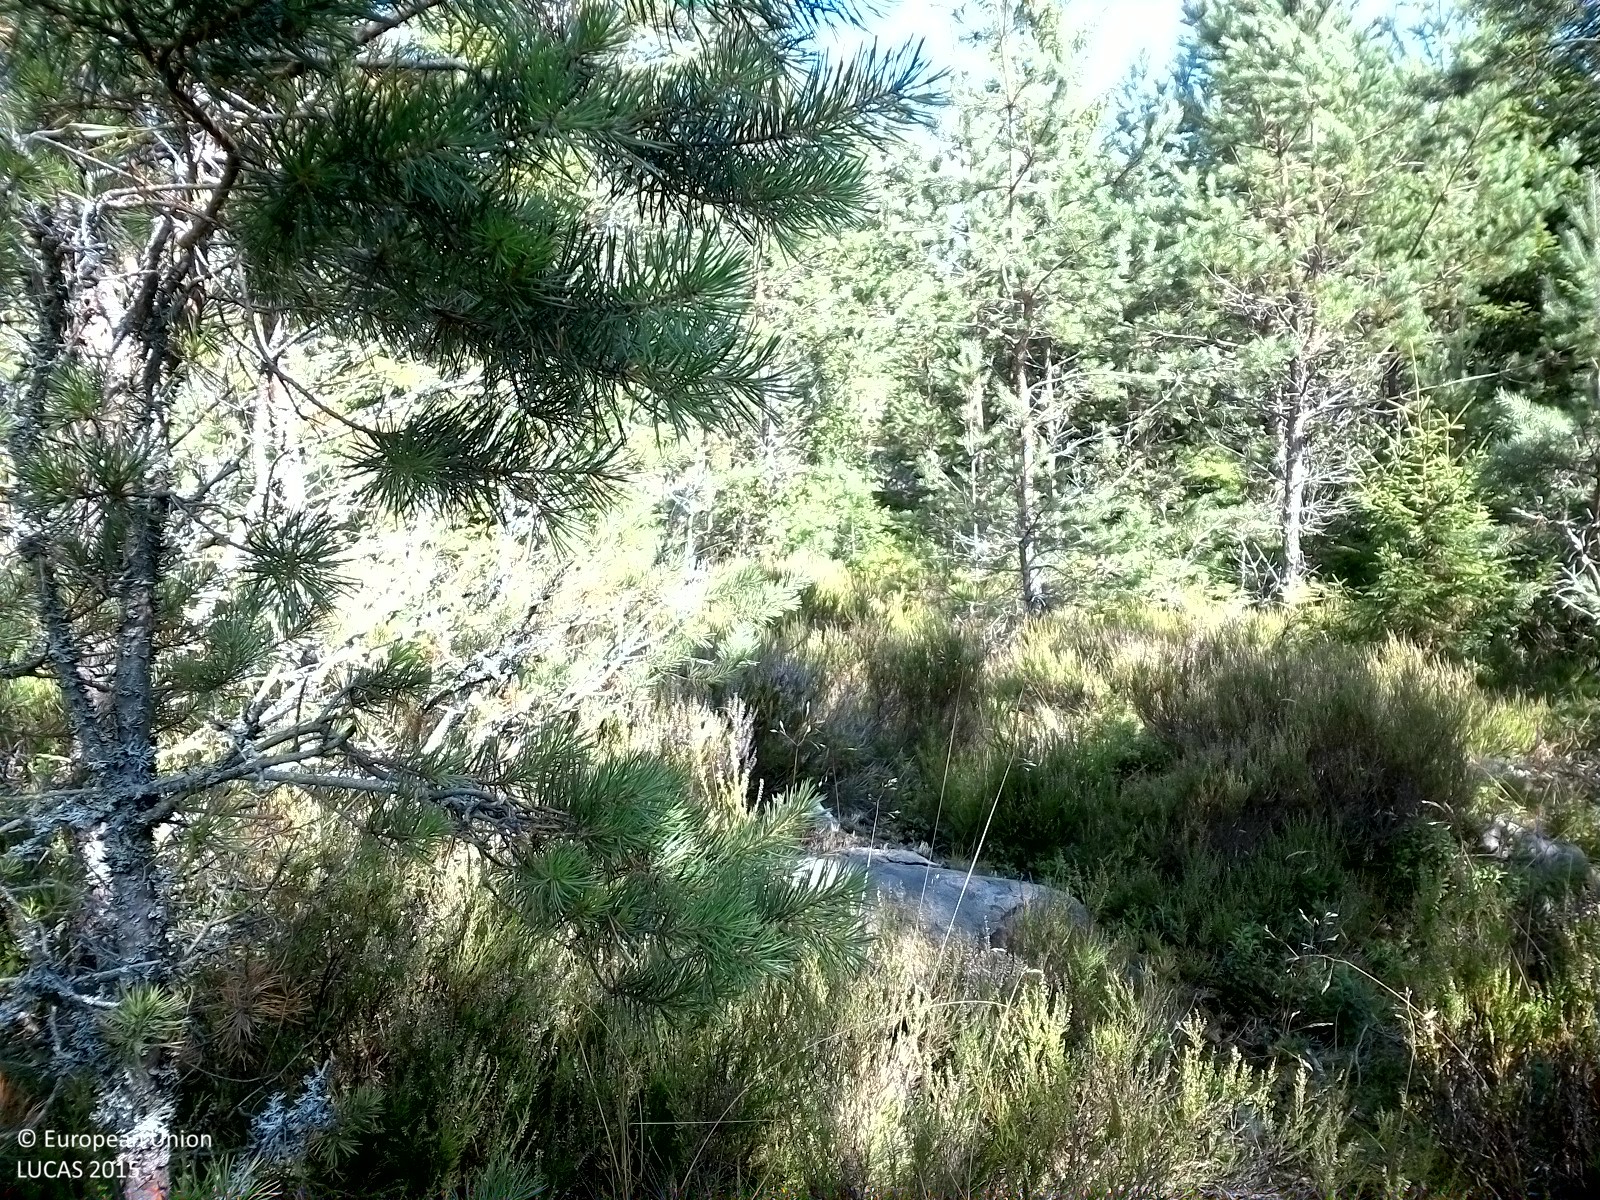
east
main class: Woodland
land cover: Pine dominated coniferous woodland
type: boreal forest
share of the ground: 50 - 75 %
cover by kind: coniferous forest trees 55 %, herbaceous plants 25 %, shrubs 15 %, lichens and mosses 5 %
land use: Forestry
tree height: < 5 m
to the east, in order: Pine dominated coniferous woodland
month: August
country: SE
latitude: 58.9959
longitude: 15.3708
